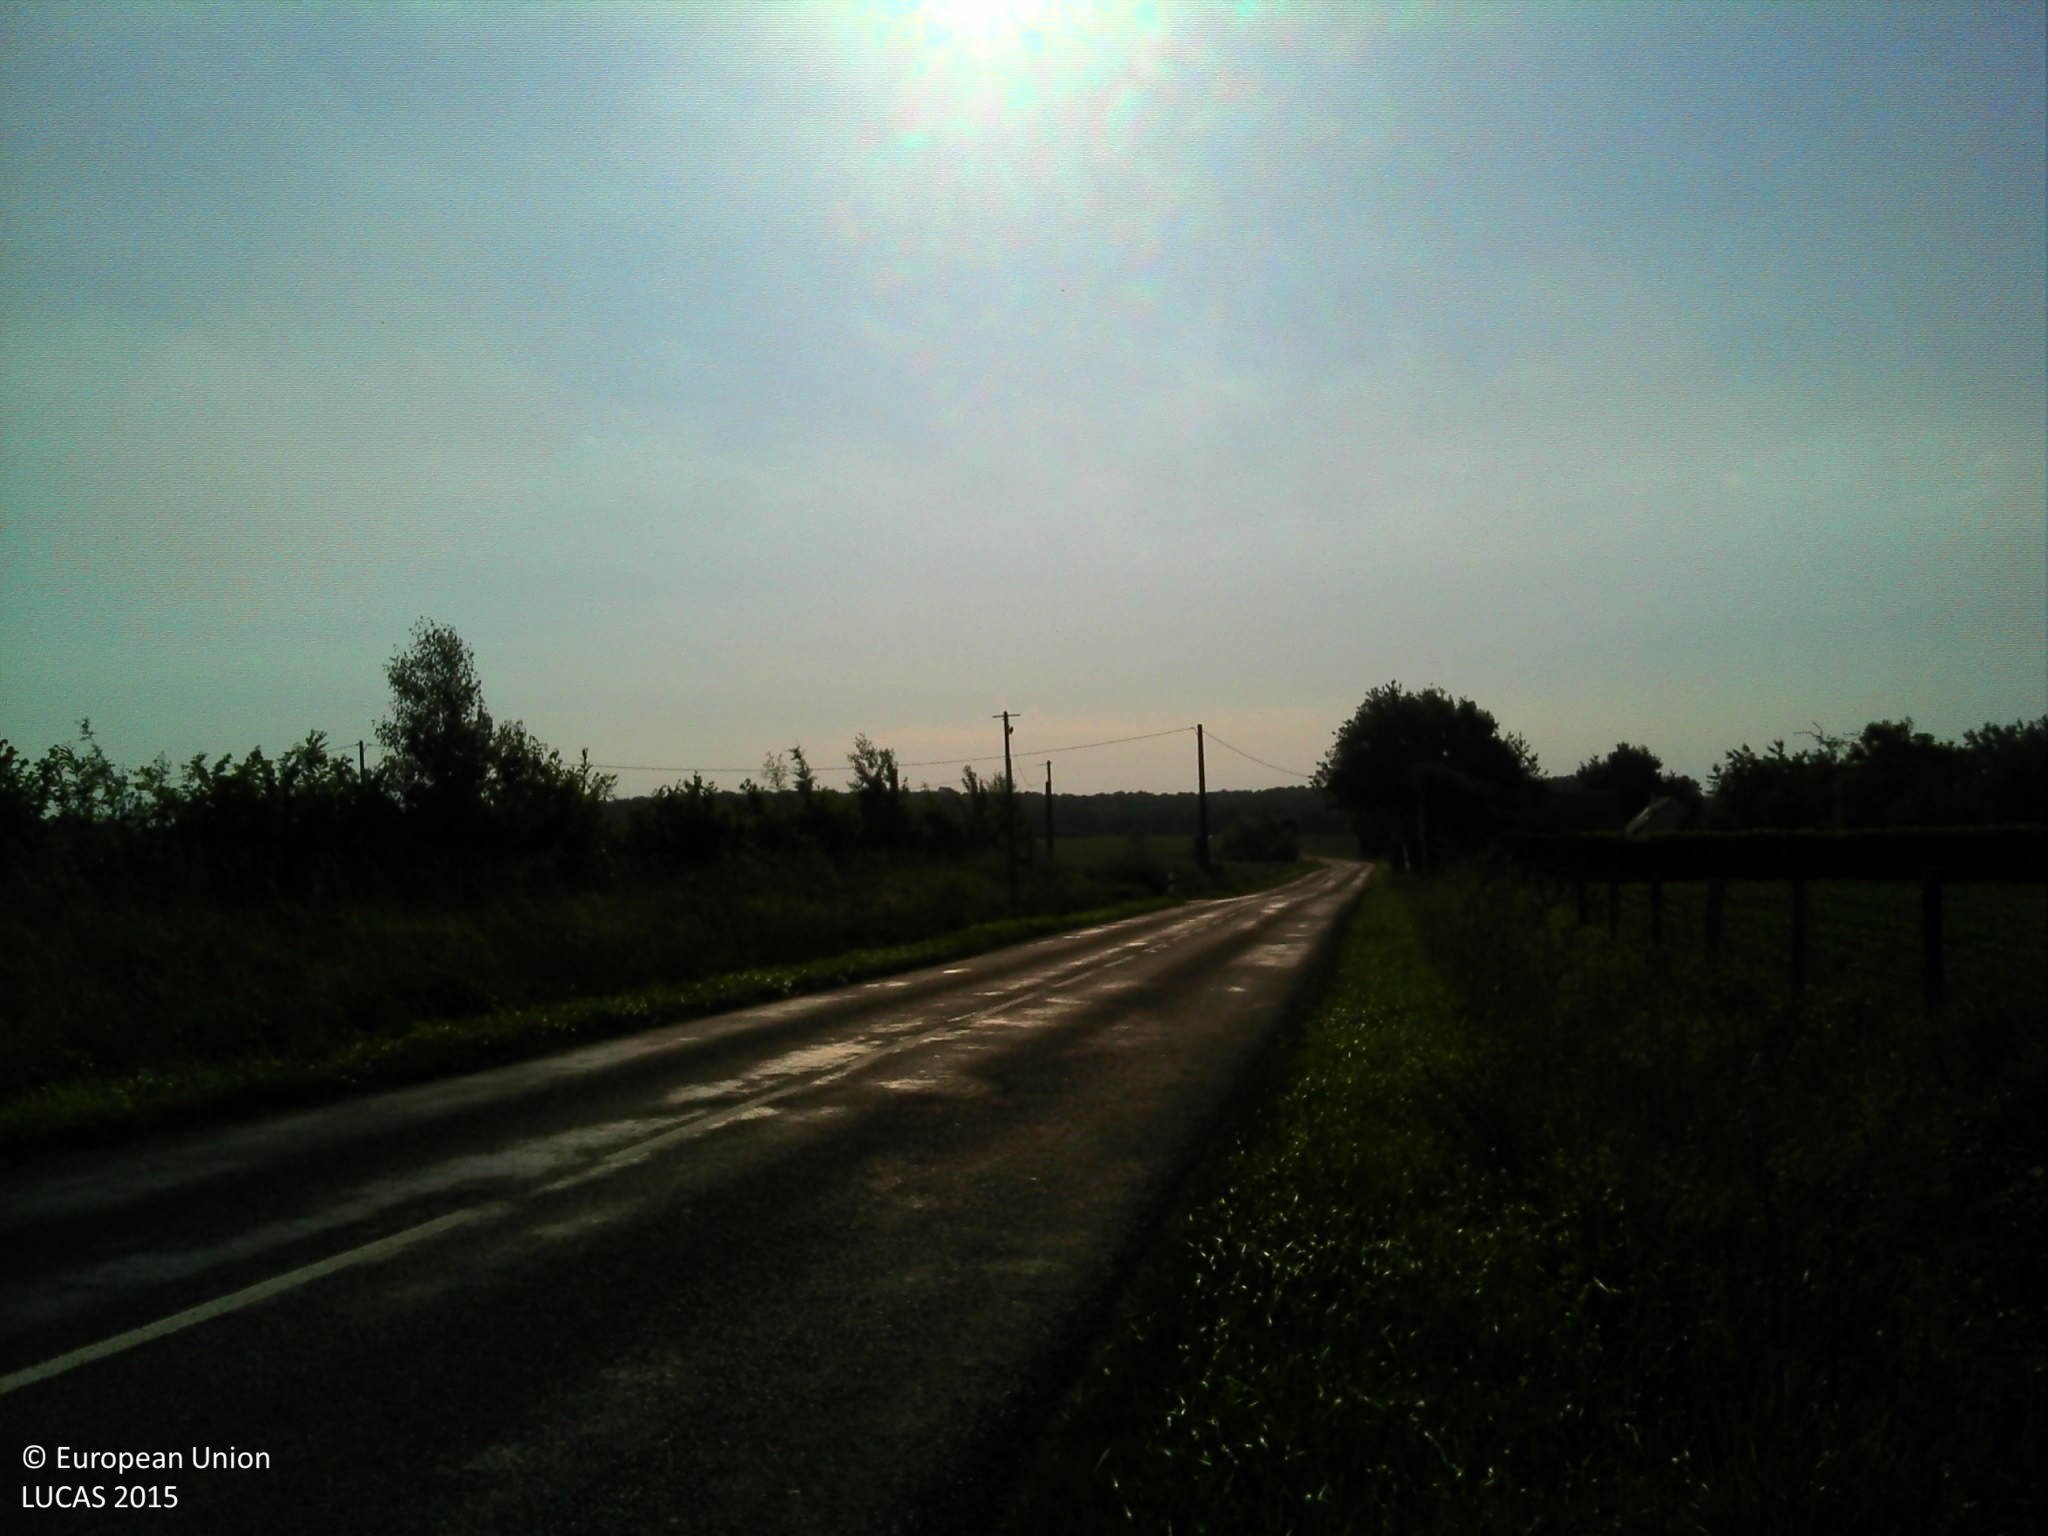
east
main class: Cropland
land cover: Maize
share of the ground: < 10 %
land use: Agriculture (excluding fallow land and kitchen gardens)
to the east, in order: Maize; Fences; Ditches and canals; Grass margins; Paved roads, cycling and walking lanes; Electric lines; Grass margins; Ditches and canals; Managed hedges; Common wheat
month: June
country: FR
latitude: 47.9310
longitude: 0.0006
